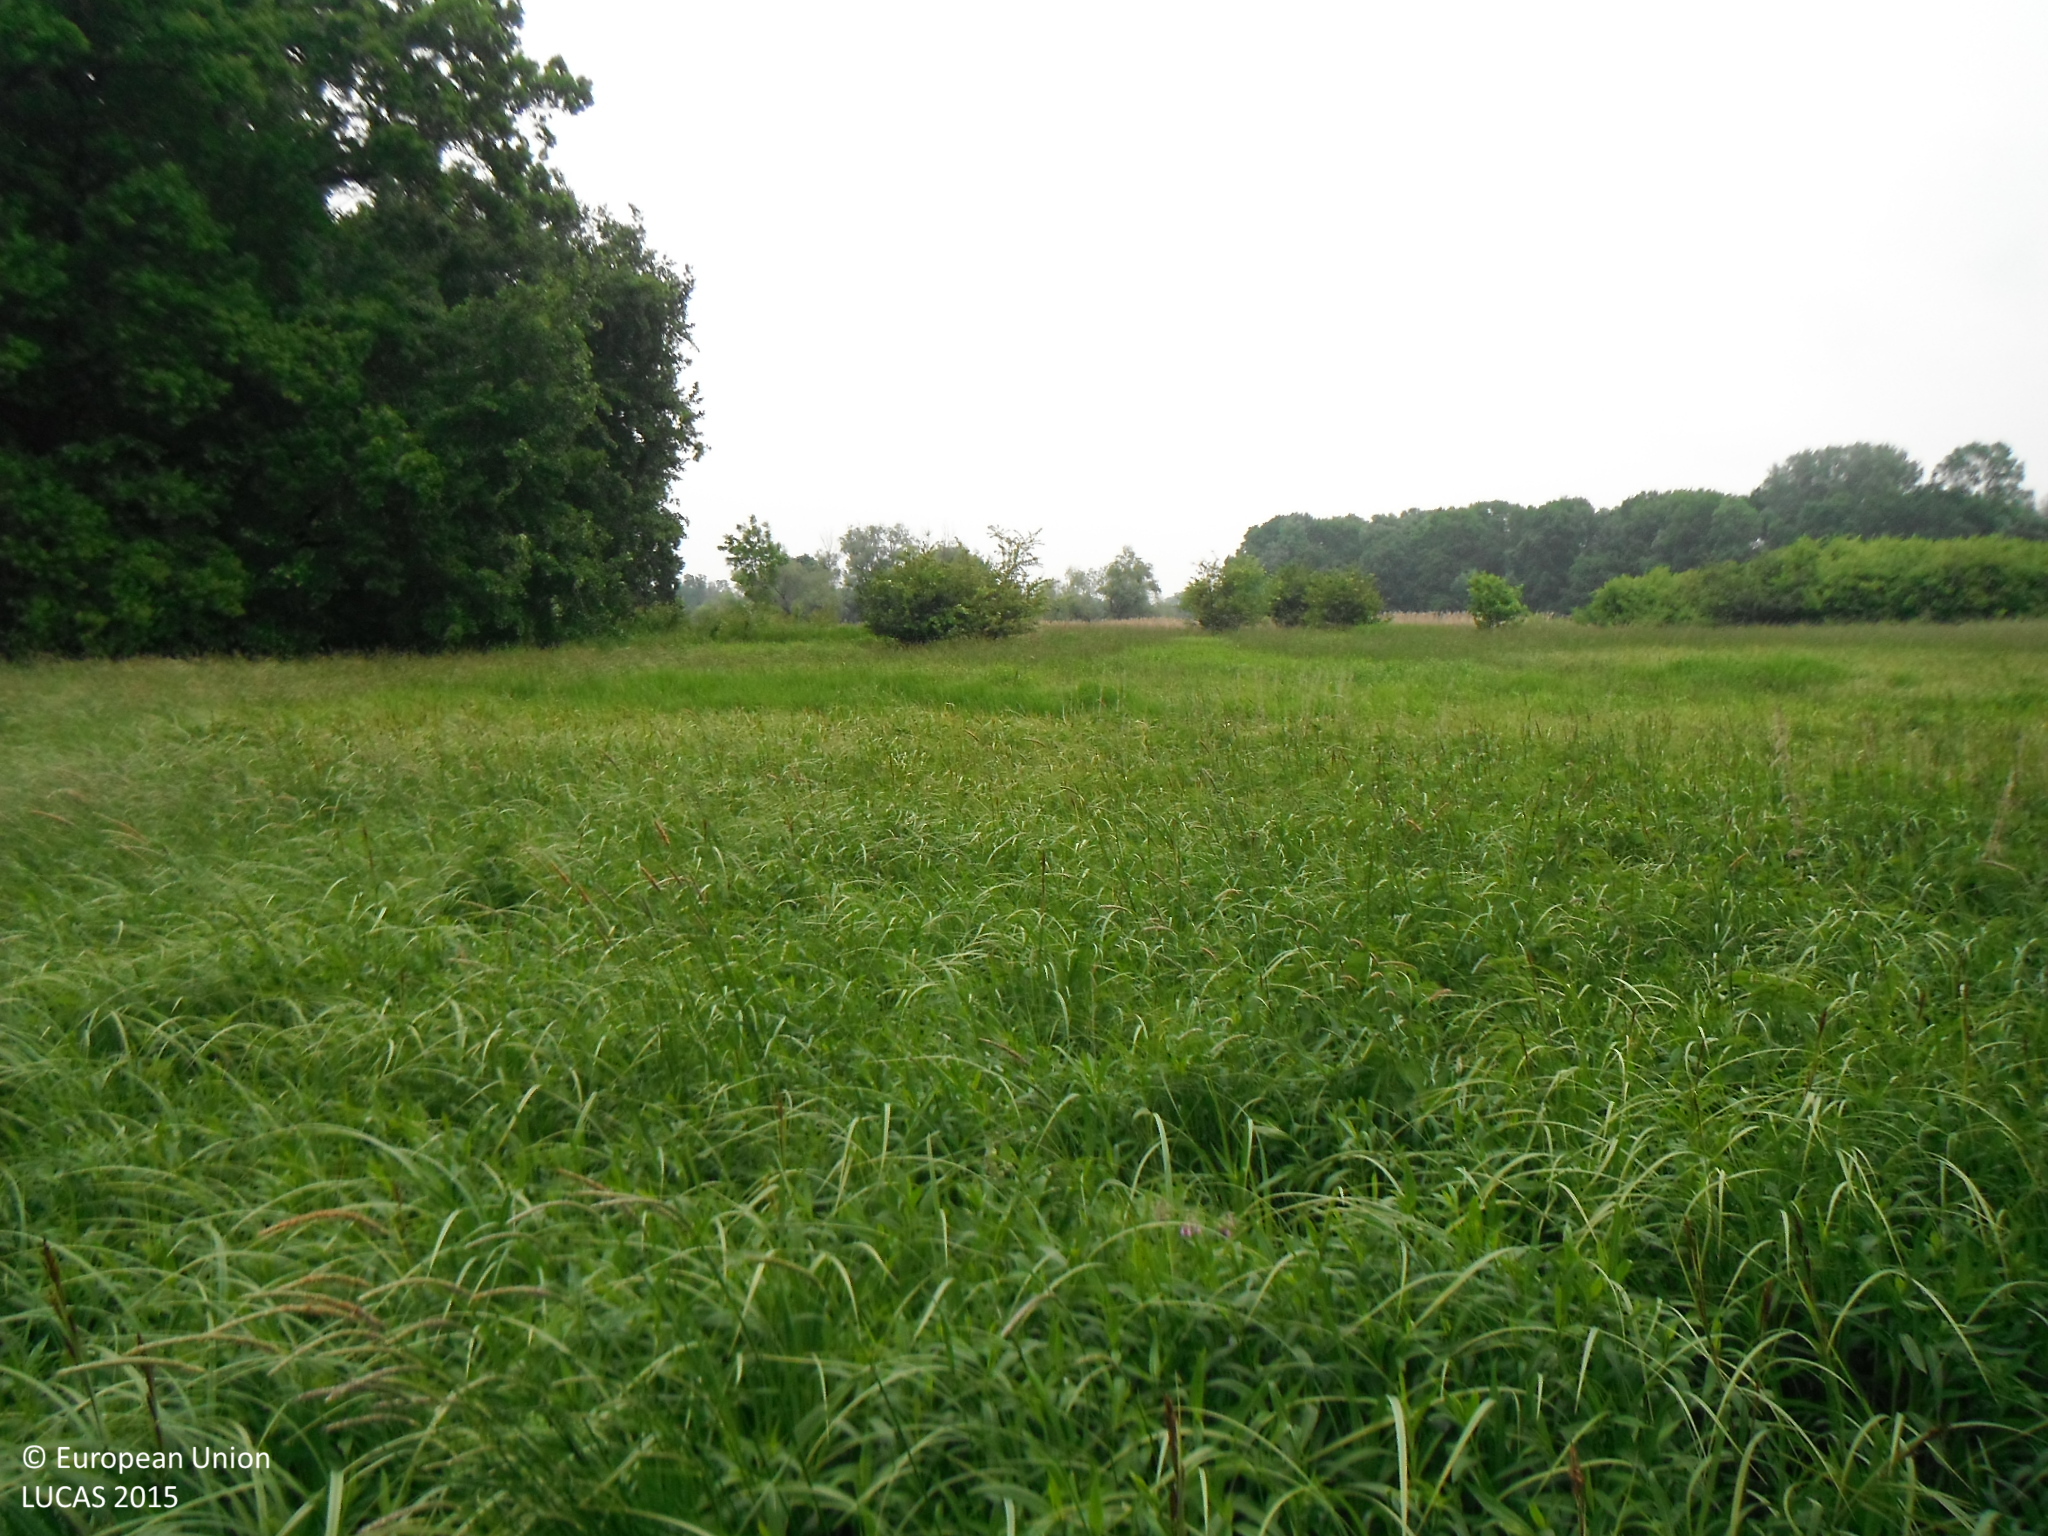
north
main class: Grassland
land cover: Spontaneously vegetated surfaces
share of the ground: > 75 %
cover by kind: herbaceous plants 100 %
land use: Semi-natural and natural areas not in use
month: May
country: SK
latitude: 48.5454
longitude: 16.9570
